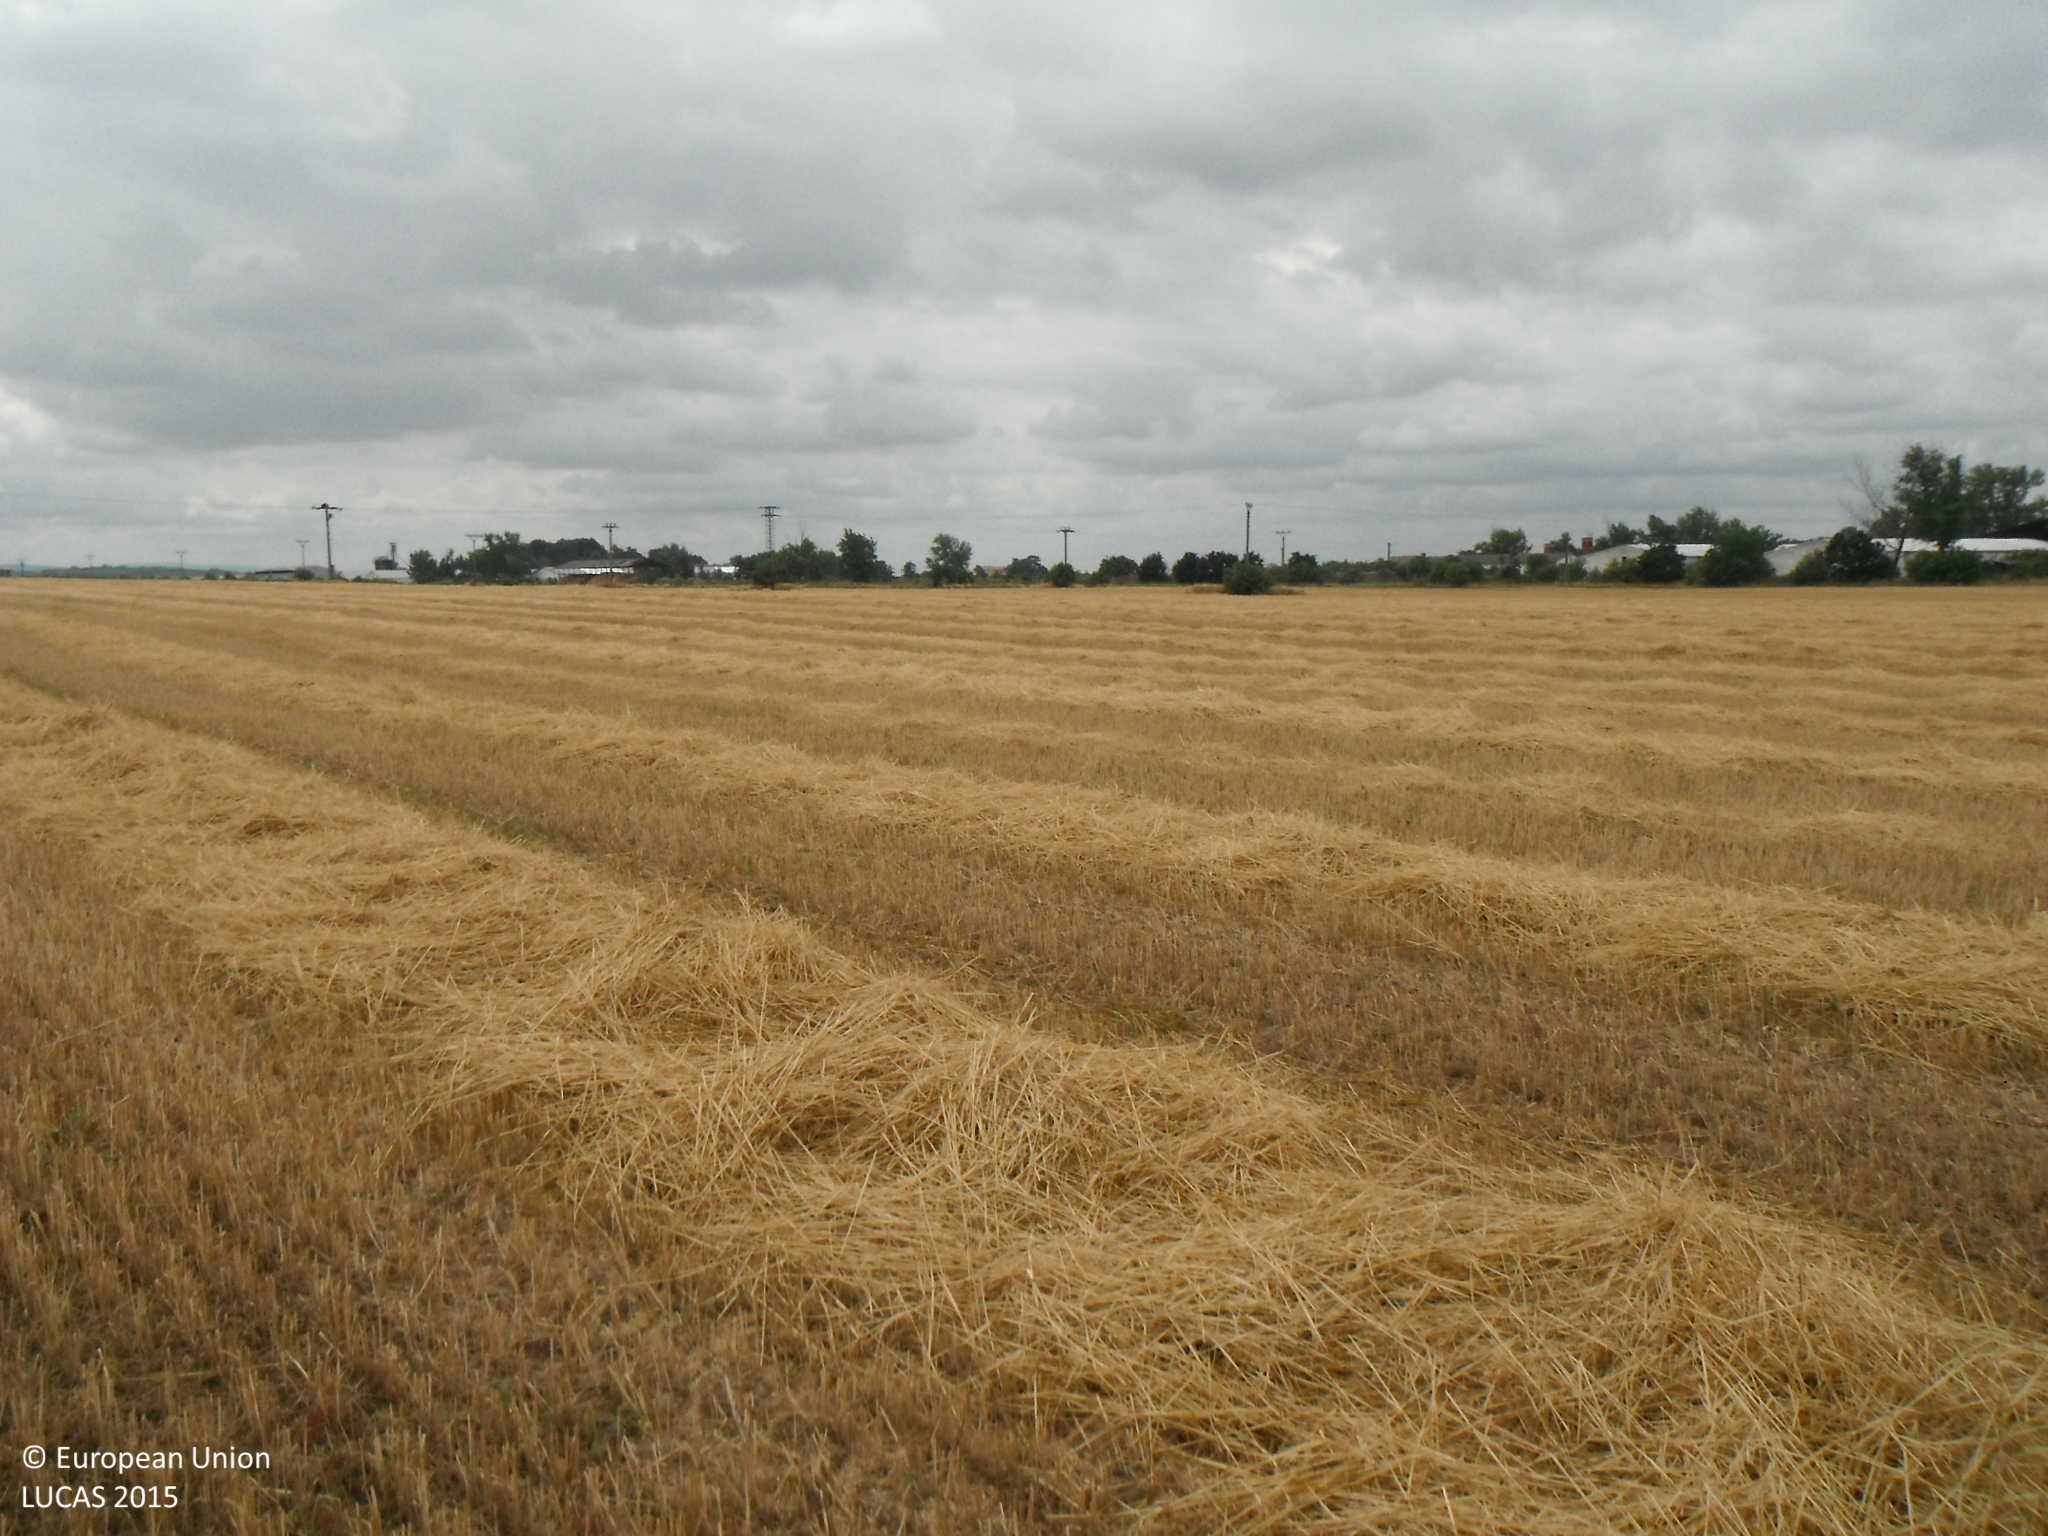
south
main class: Cropland
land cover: Common wheat
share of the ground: > 75 %
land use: Agriculture (excluding fallow land and kitchen gardens)
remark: Harvested field
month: July
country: SK
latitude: 47.8589
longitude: 18.2605
